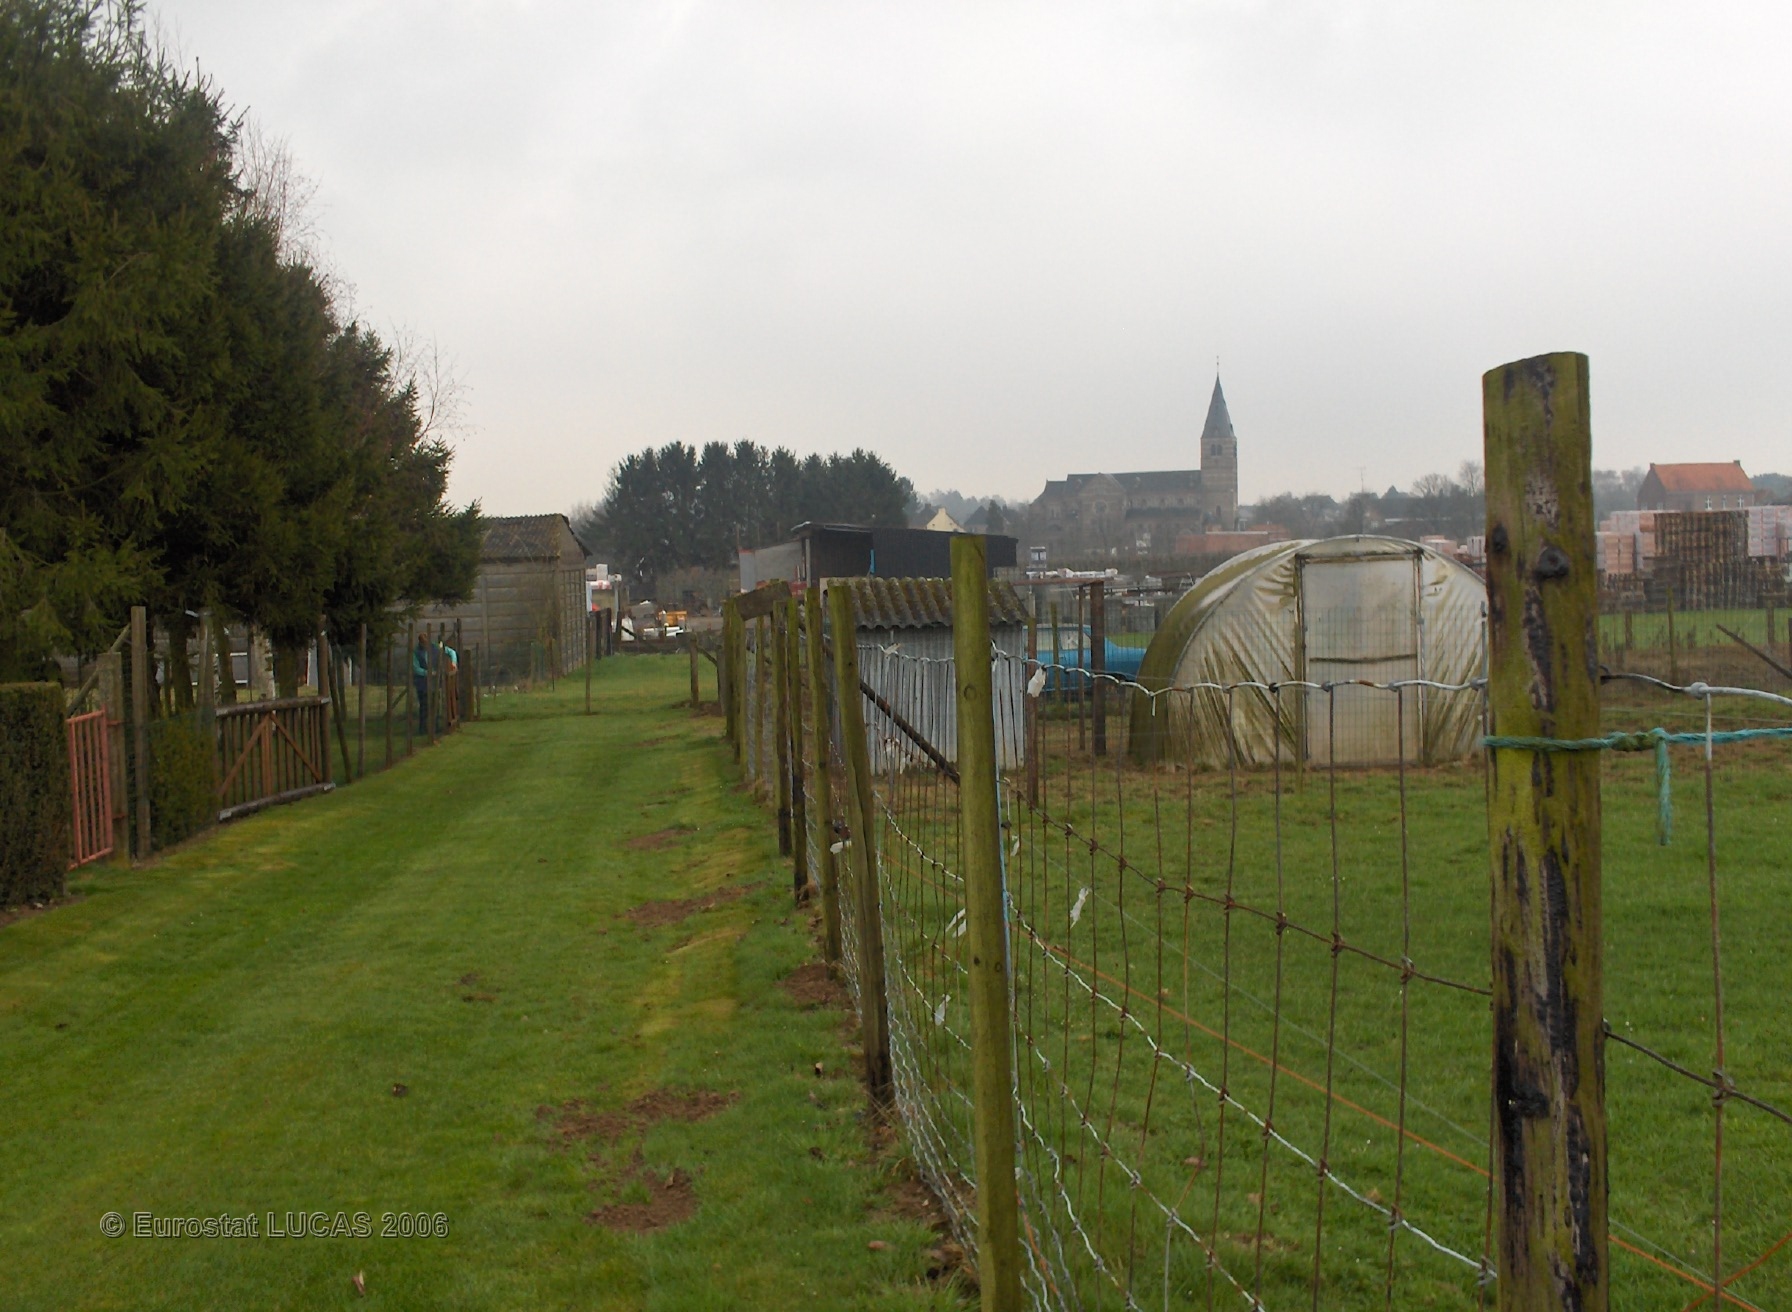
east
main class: Grassland
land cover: Grassland with sparse tree/shrub cover
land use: Agriculture (excluding fallow land and kitchen gardens)
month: April
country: BE
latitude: 50.8773
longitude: 5.2366
